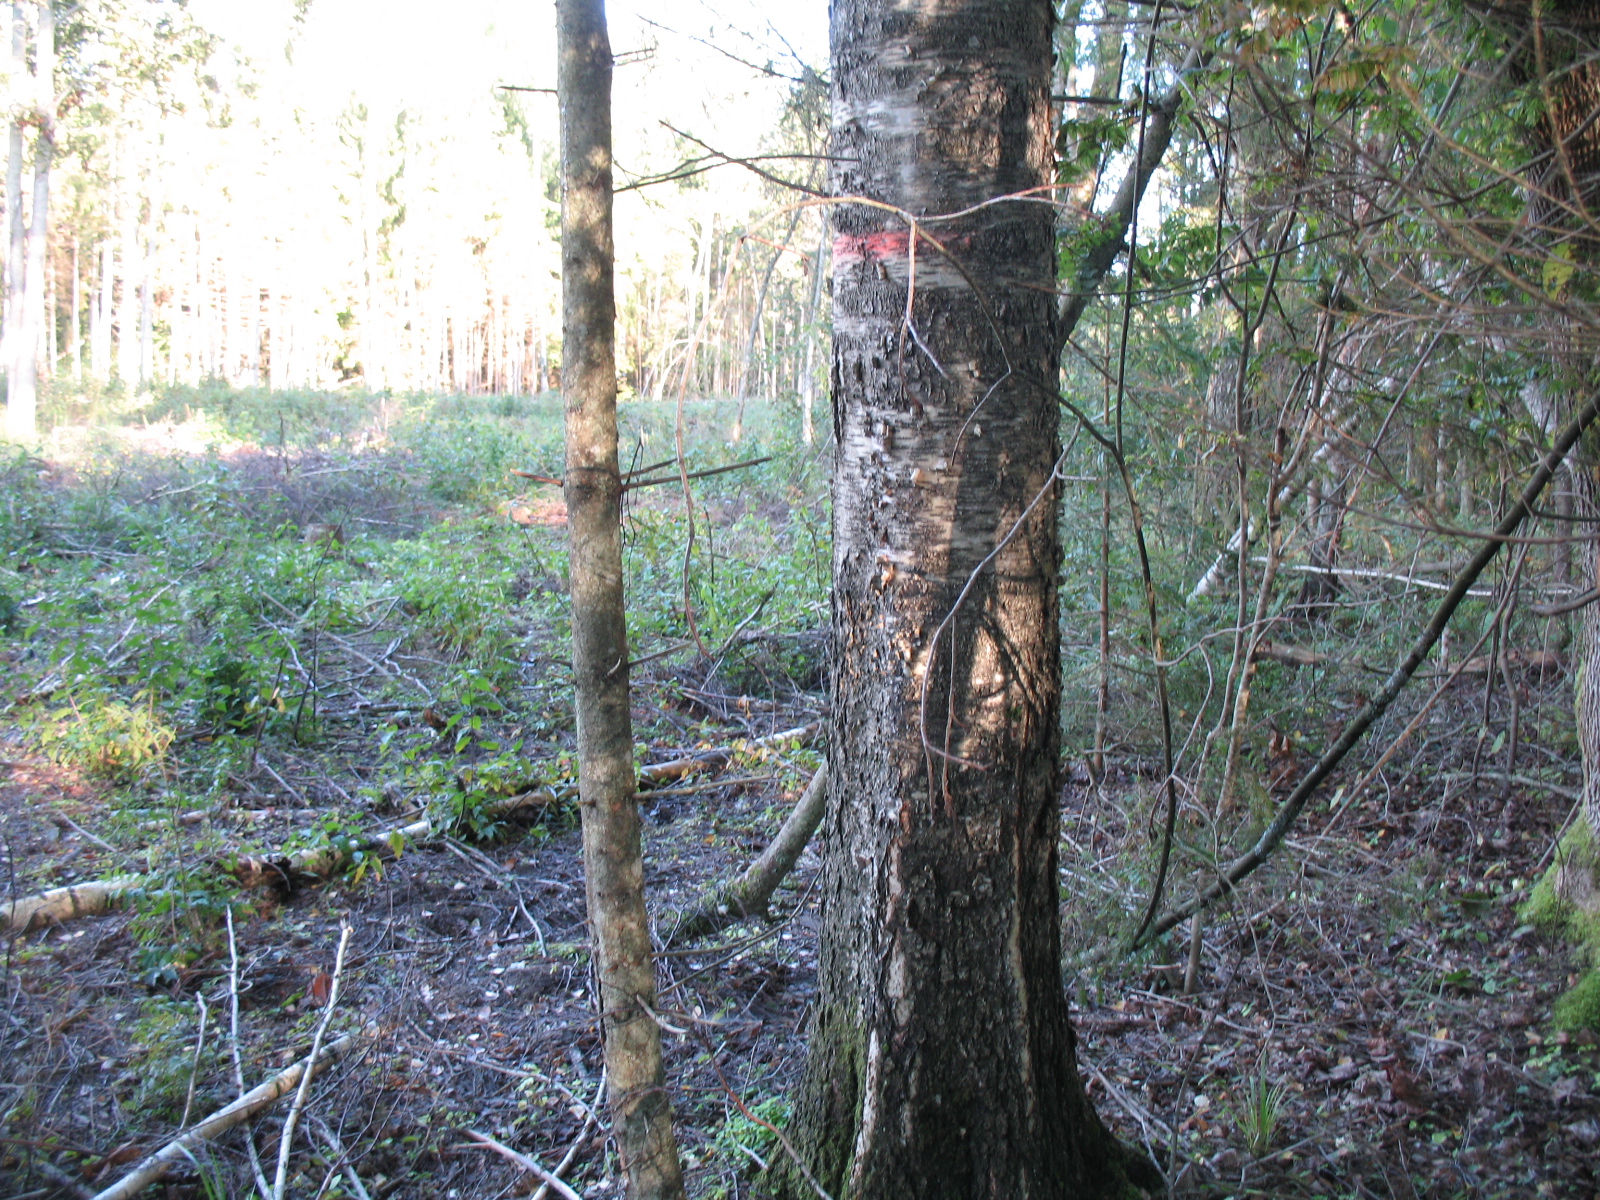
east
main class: Woodland
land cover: Spruce dominated mixed woodland
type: hemiboreal forest and nemoral coniferous forest and mixed broadleaved-coniferous forest
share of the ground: > 75 %
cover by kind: broadleaved forest trees 55 %, coniferous forest trees 25 %, shrubs 10 %, herbaceous plants 10 %
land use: Forestry
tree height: > 5 m
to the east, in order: Spruce dominated mixed woodland; Spontaneously vegetated surfaces; Broadleaved woodland; Spontaneously vegetated surfaces; Spruce dominated mixed woodland; Spontaneously vegetated surfaces
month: September
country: LV
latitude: 56.1396
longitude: 25.9201
